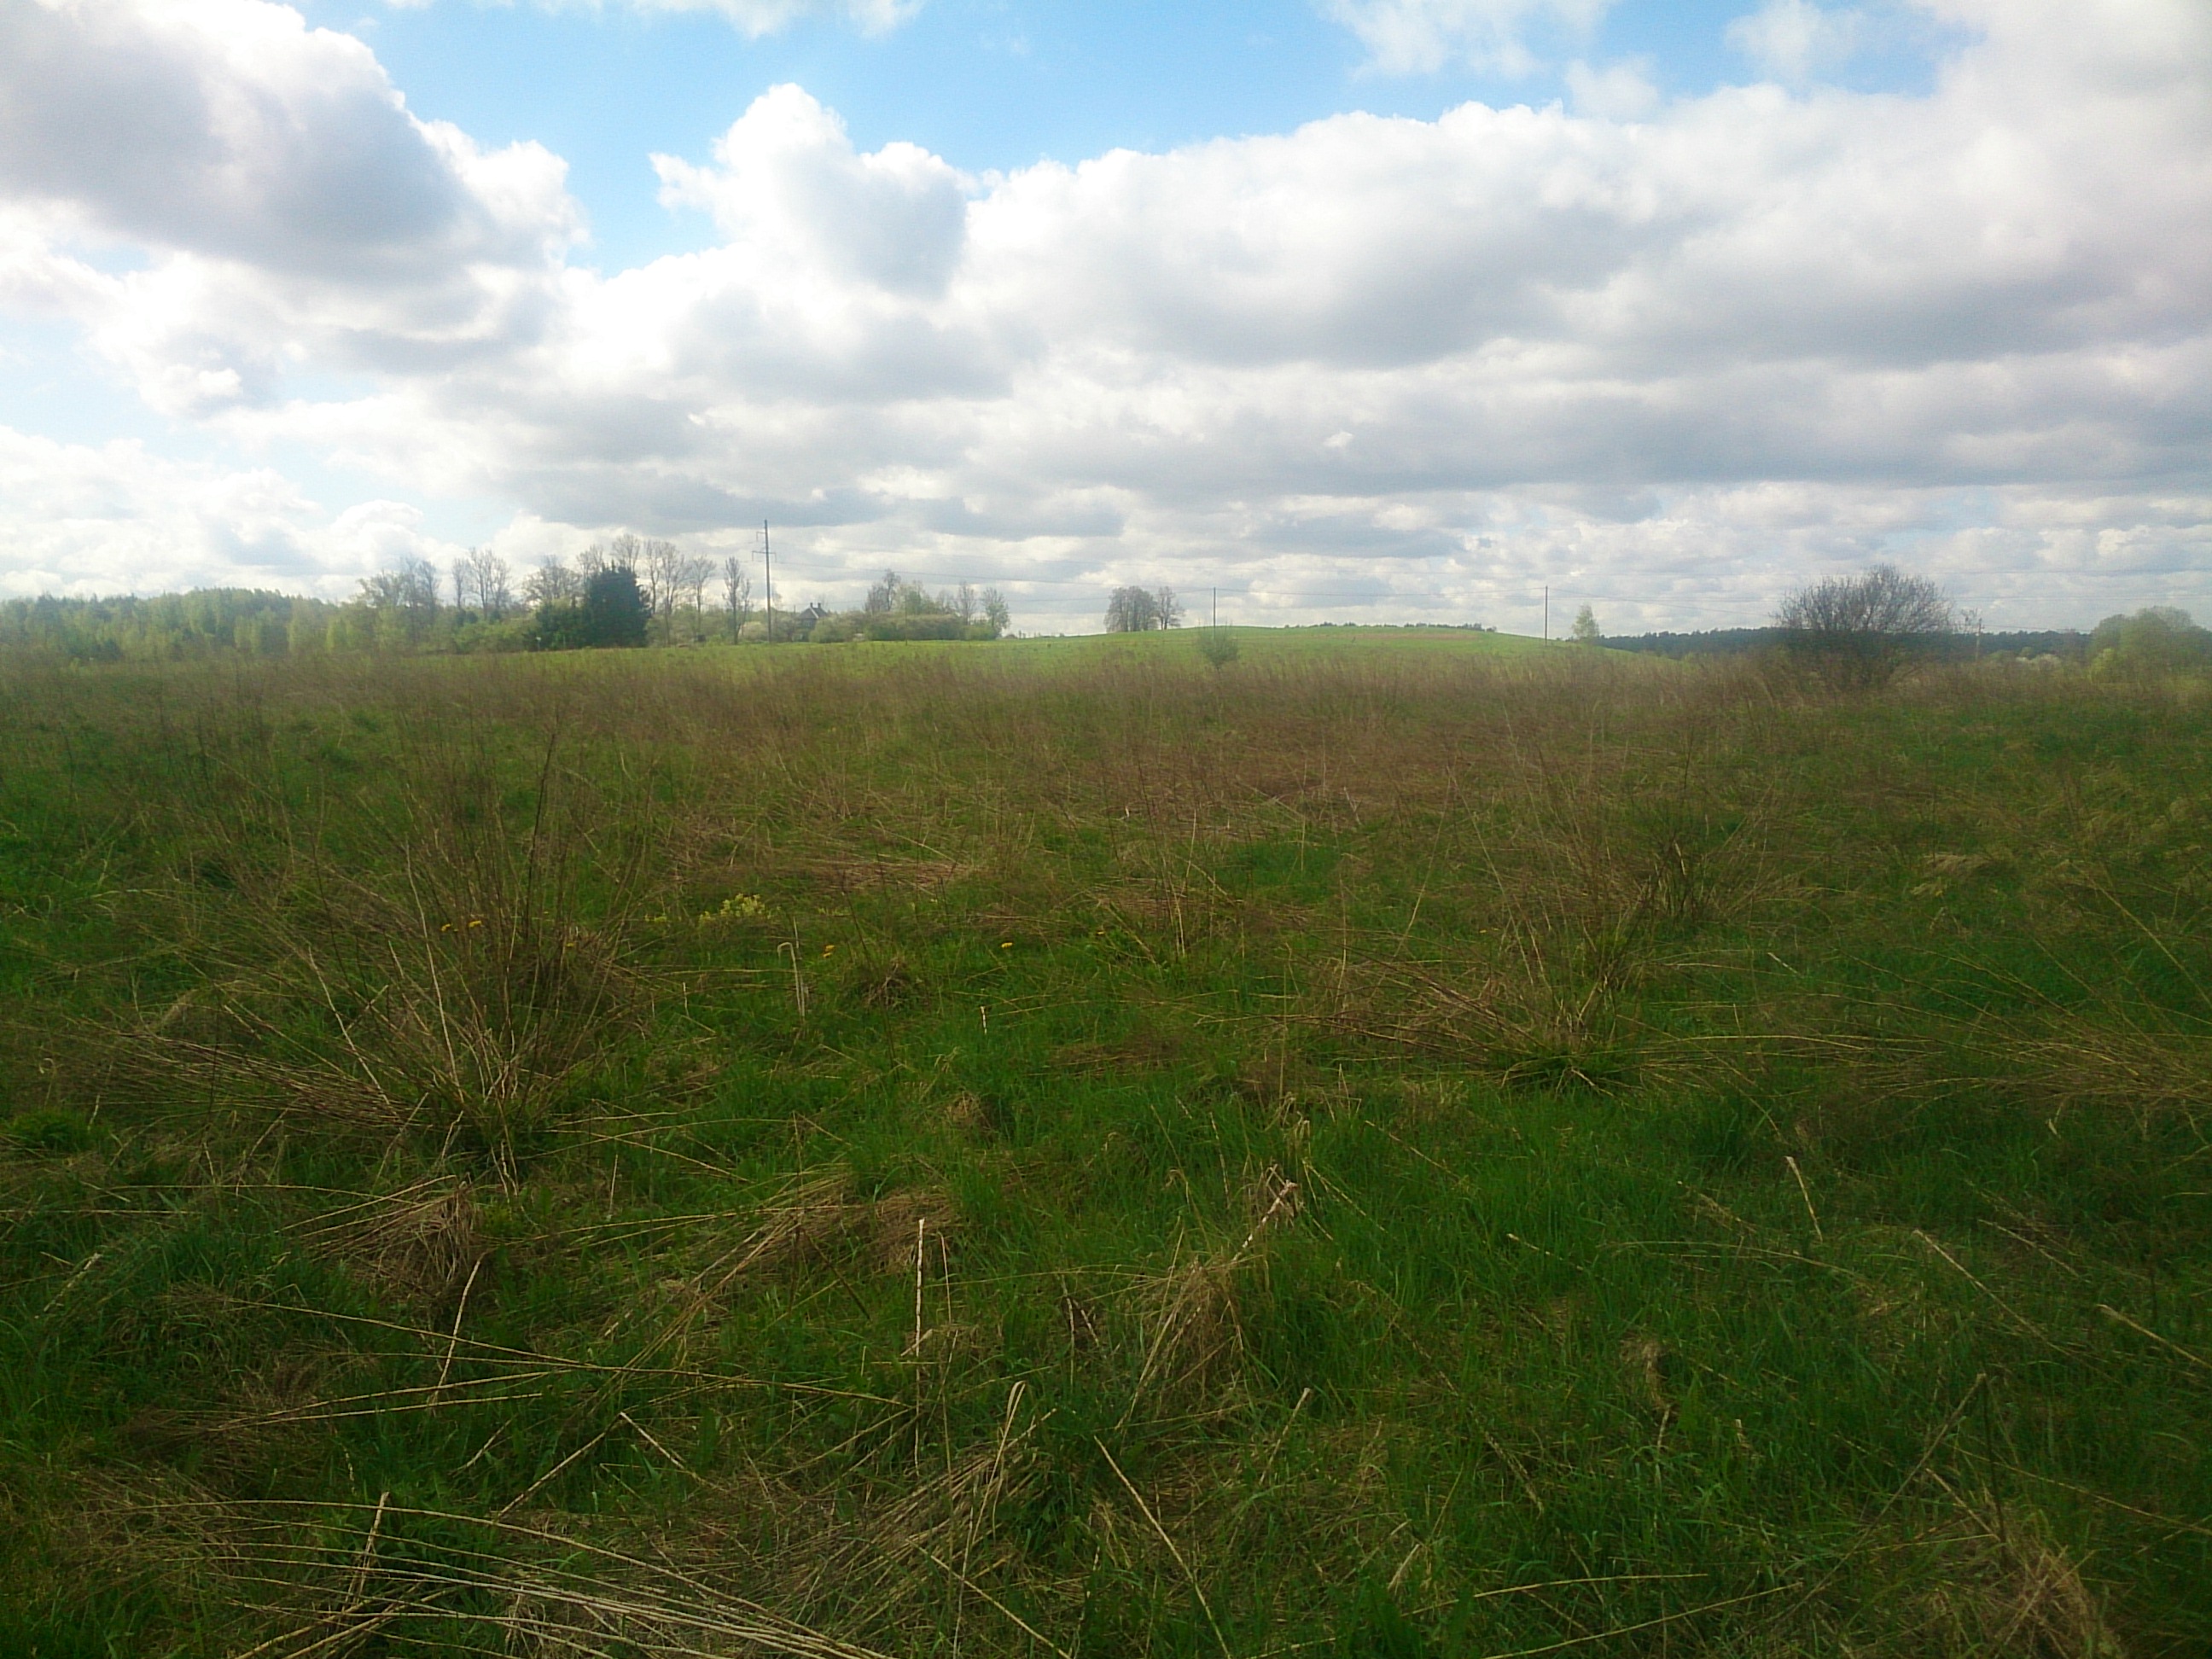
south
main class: Grassland
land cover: Spontaneously vegetated surfaces
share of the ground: > 75 %
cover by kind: herbaceous plants 100 %
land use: Abandoned areas
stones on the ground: < 10 %
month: May
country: LV
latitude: 56.7954
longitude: 24.2517
